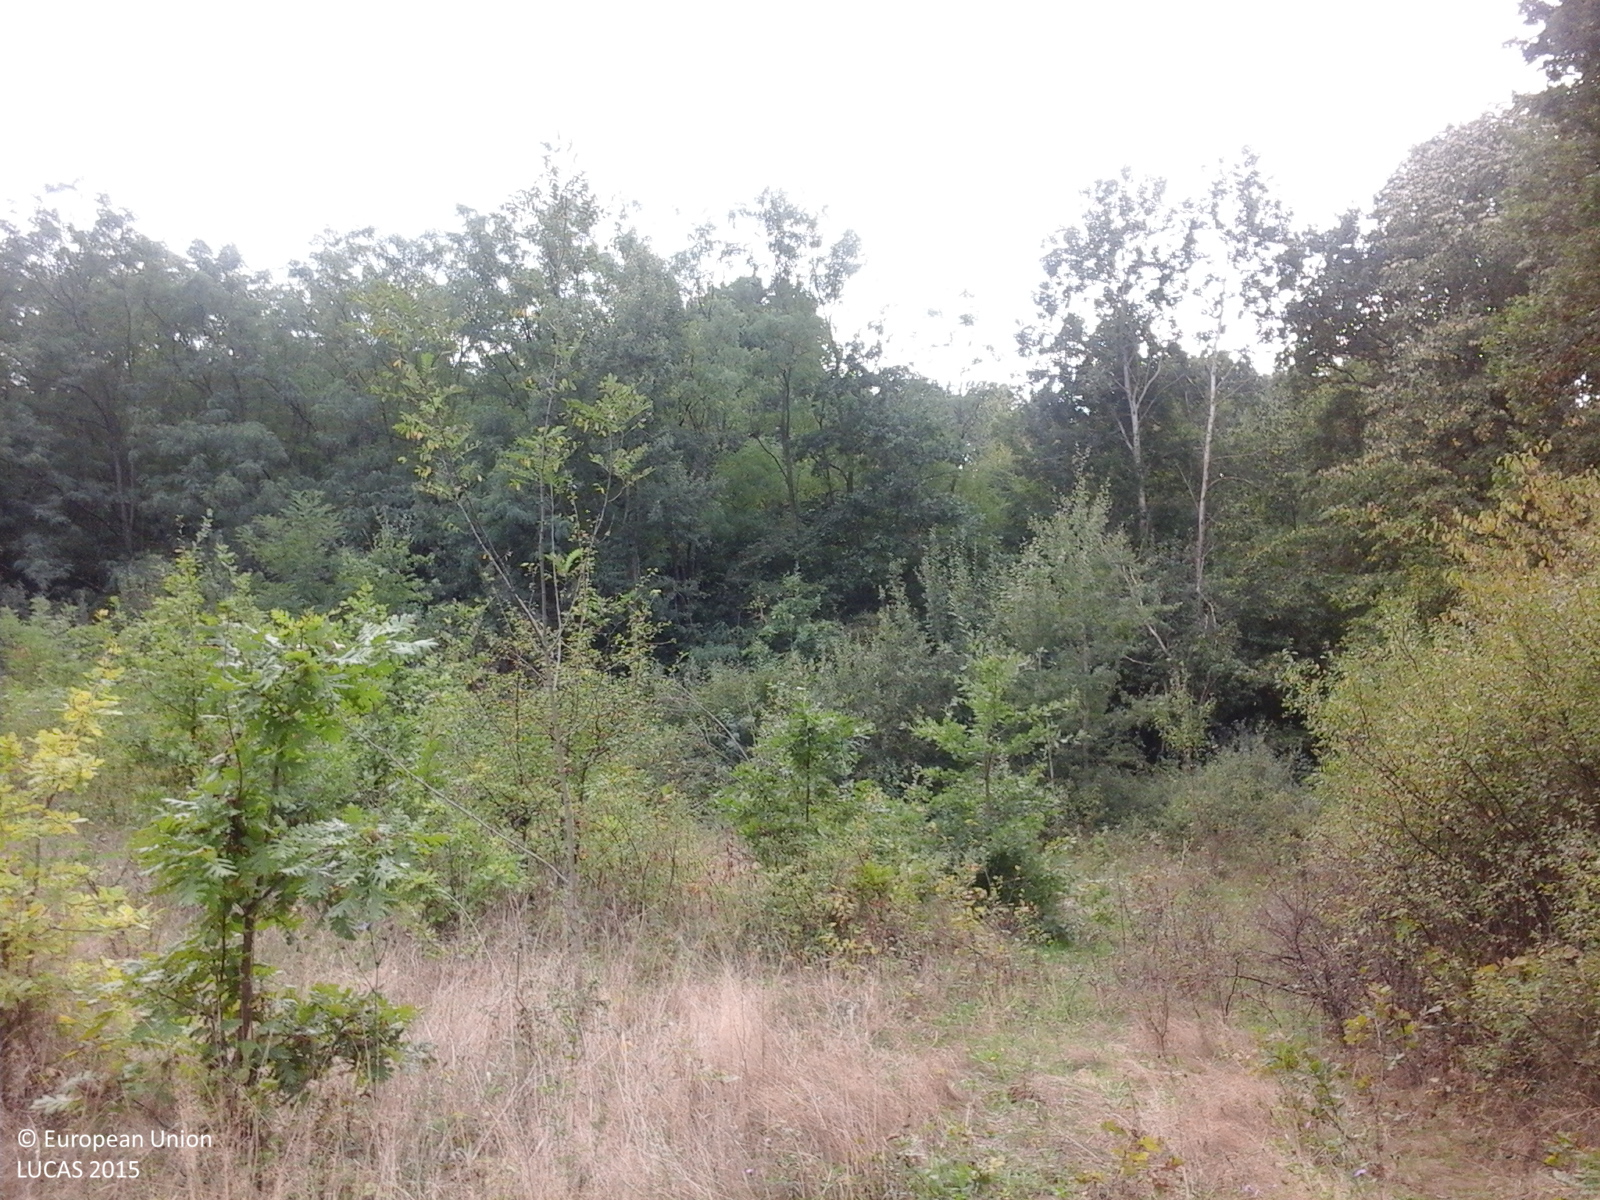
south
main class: Woodland
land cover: Broadleaved woodland
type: acidophilous oak and oak-birch forest
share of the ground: > 75 %
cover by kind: broadleaved forest trees 100 %
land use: Forestry
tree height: > 5 m
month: September
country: RO
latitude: 45.7330
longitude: 21.9519
